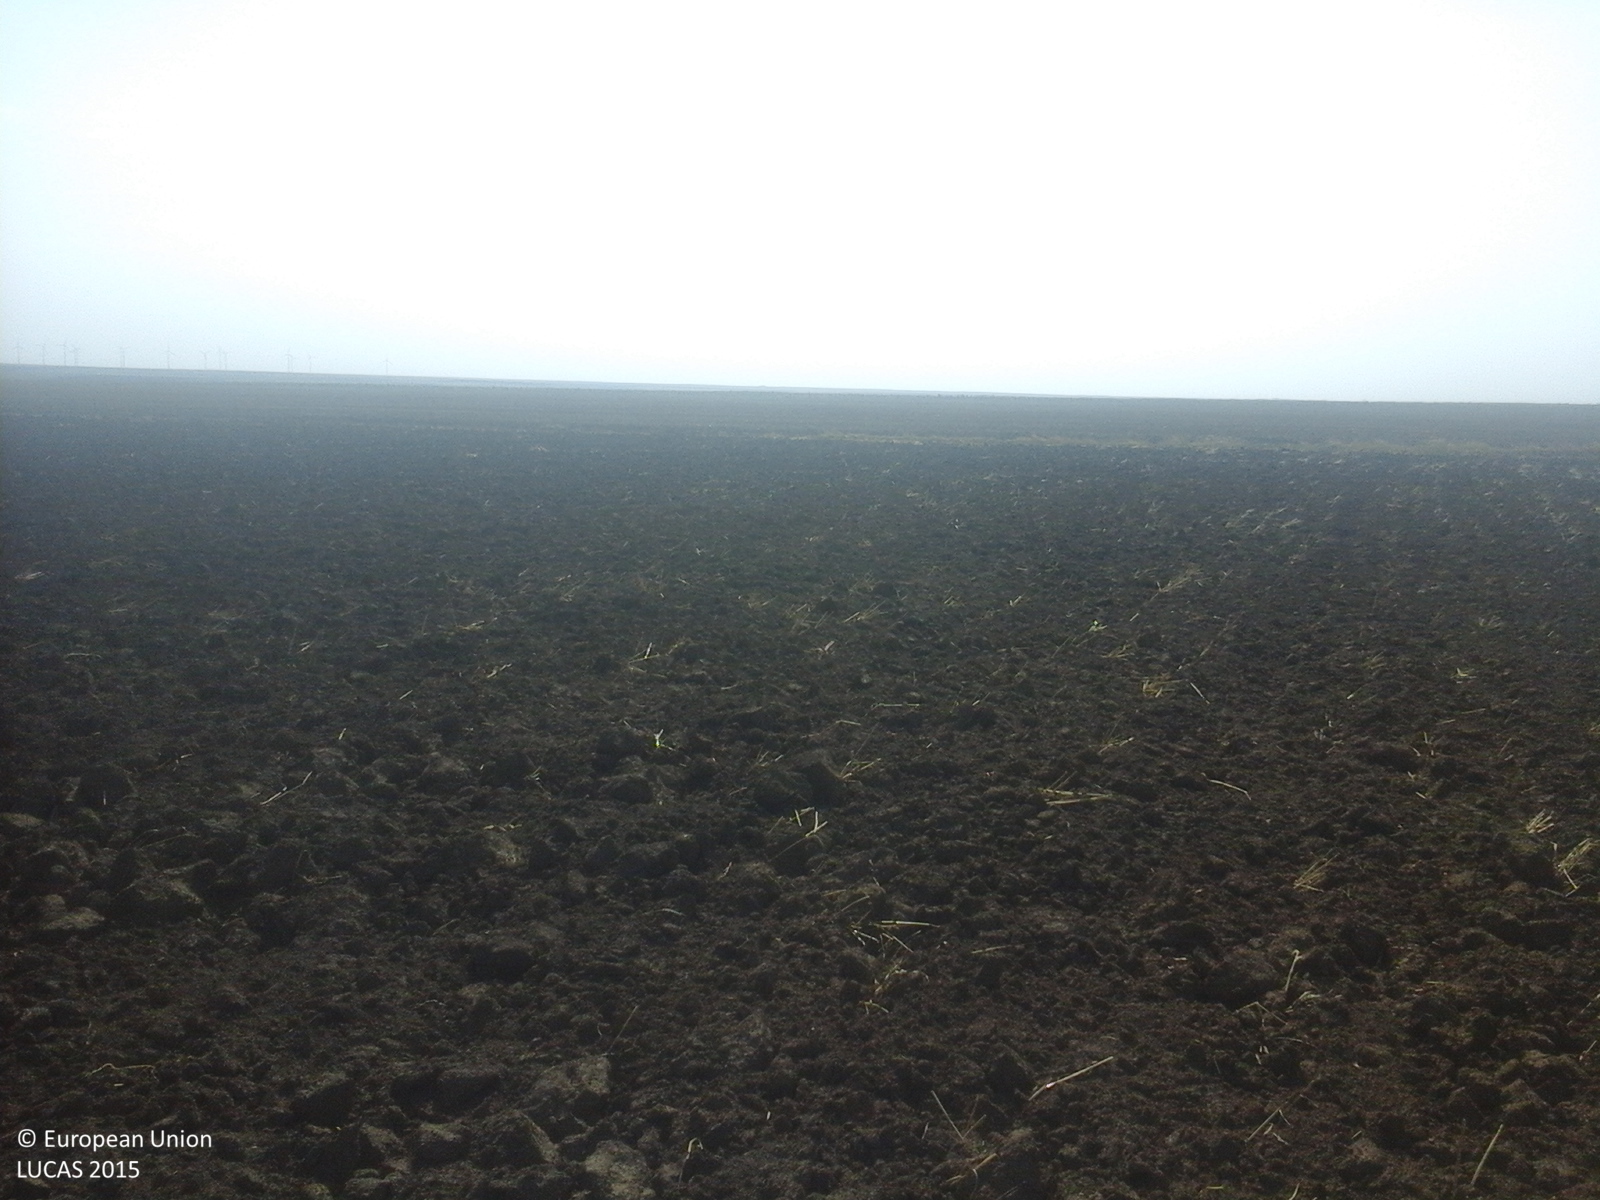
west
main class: Cropland
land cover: Common wheat
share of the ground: < 10 %
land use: Agriculture (excluding fallow land and kitchen gardens)
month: August
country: RO
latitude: 43.9536
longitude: 28.2398
